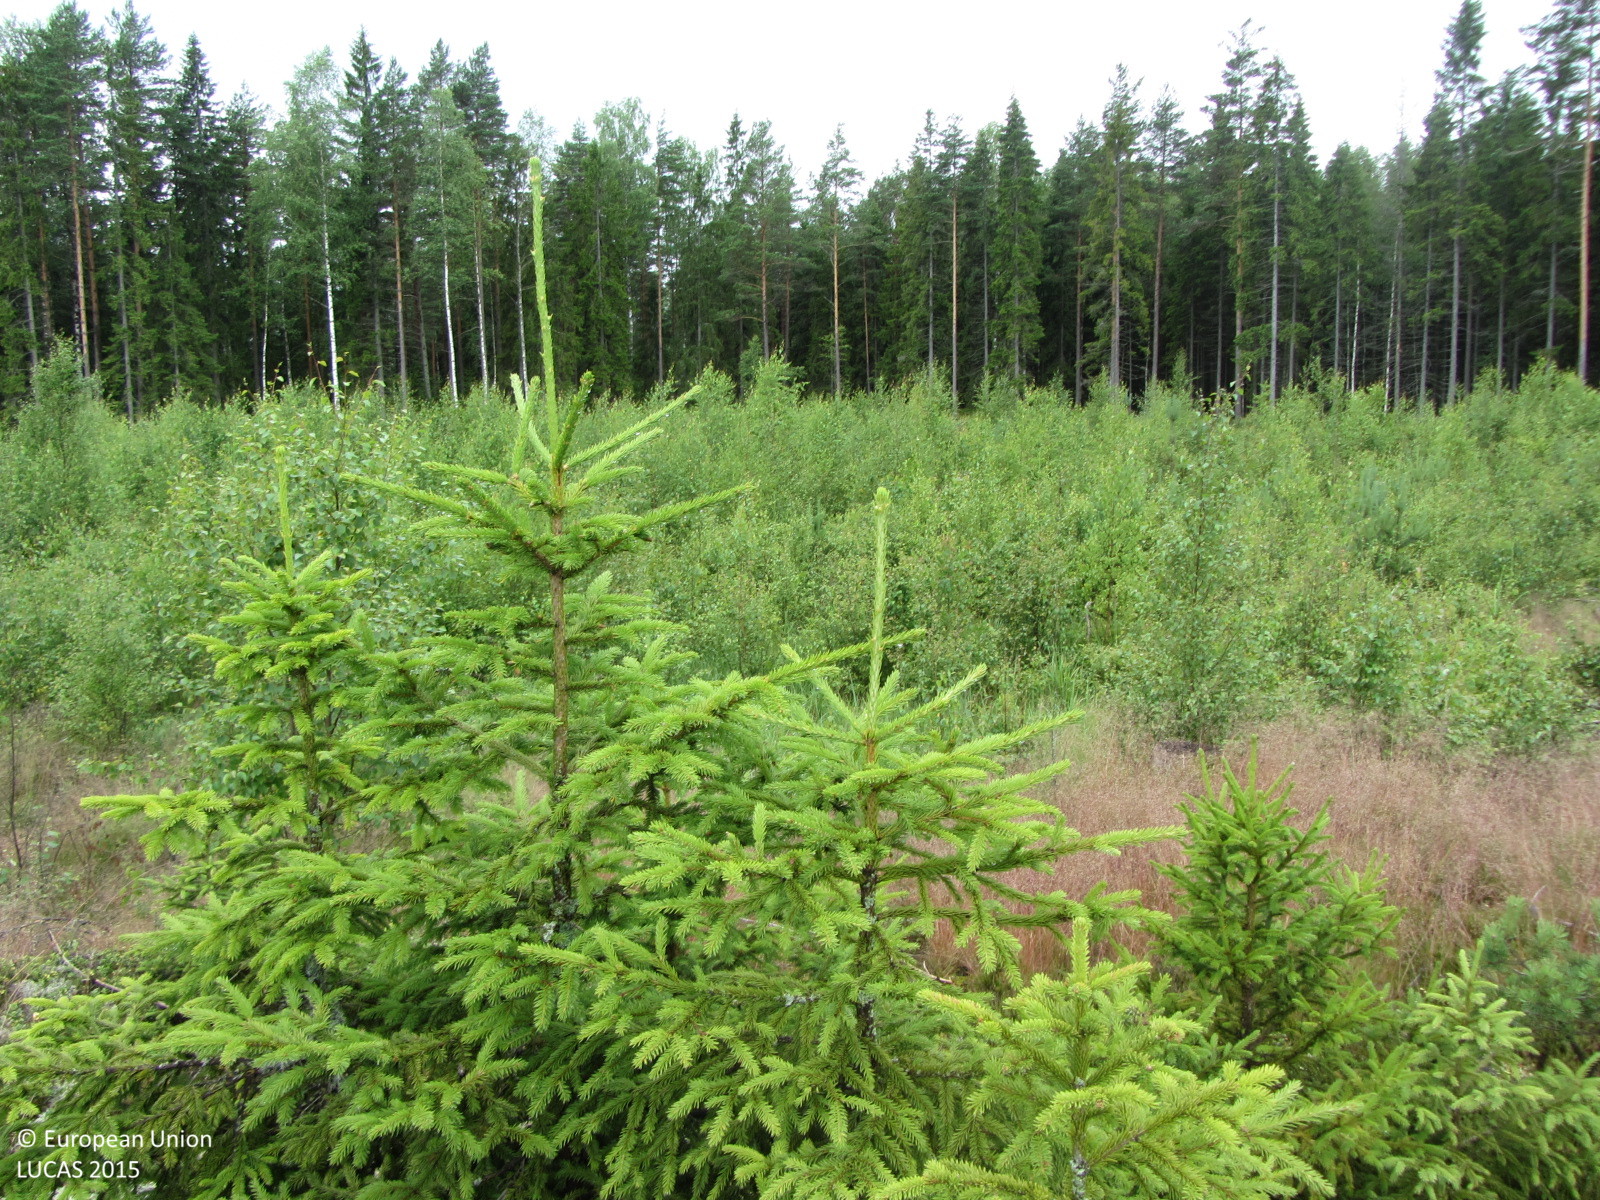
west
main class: Woodland
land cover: Other mixed woodland
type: boreal forest
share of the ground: 10 - 25 %
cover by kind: lichens and mosses 40 %, shrubs 20 %, herbaceous plants 20 %, coniferous forest trees 15 %, broadleaved forest trees 5 %
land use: Forestry
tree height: < 5 m
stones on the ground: 10 - 25 %
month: July
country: FI
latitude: 60.0935
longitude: 24.0715
